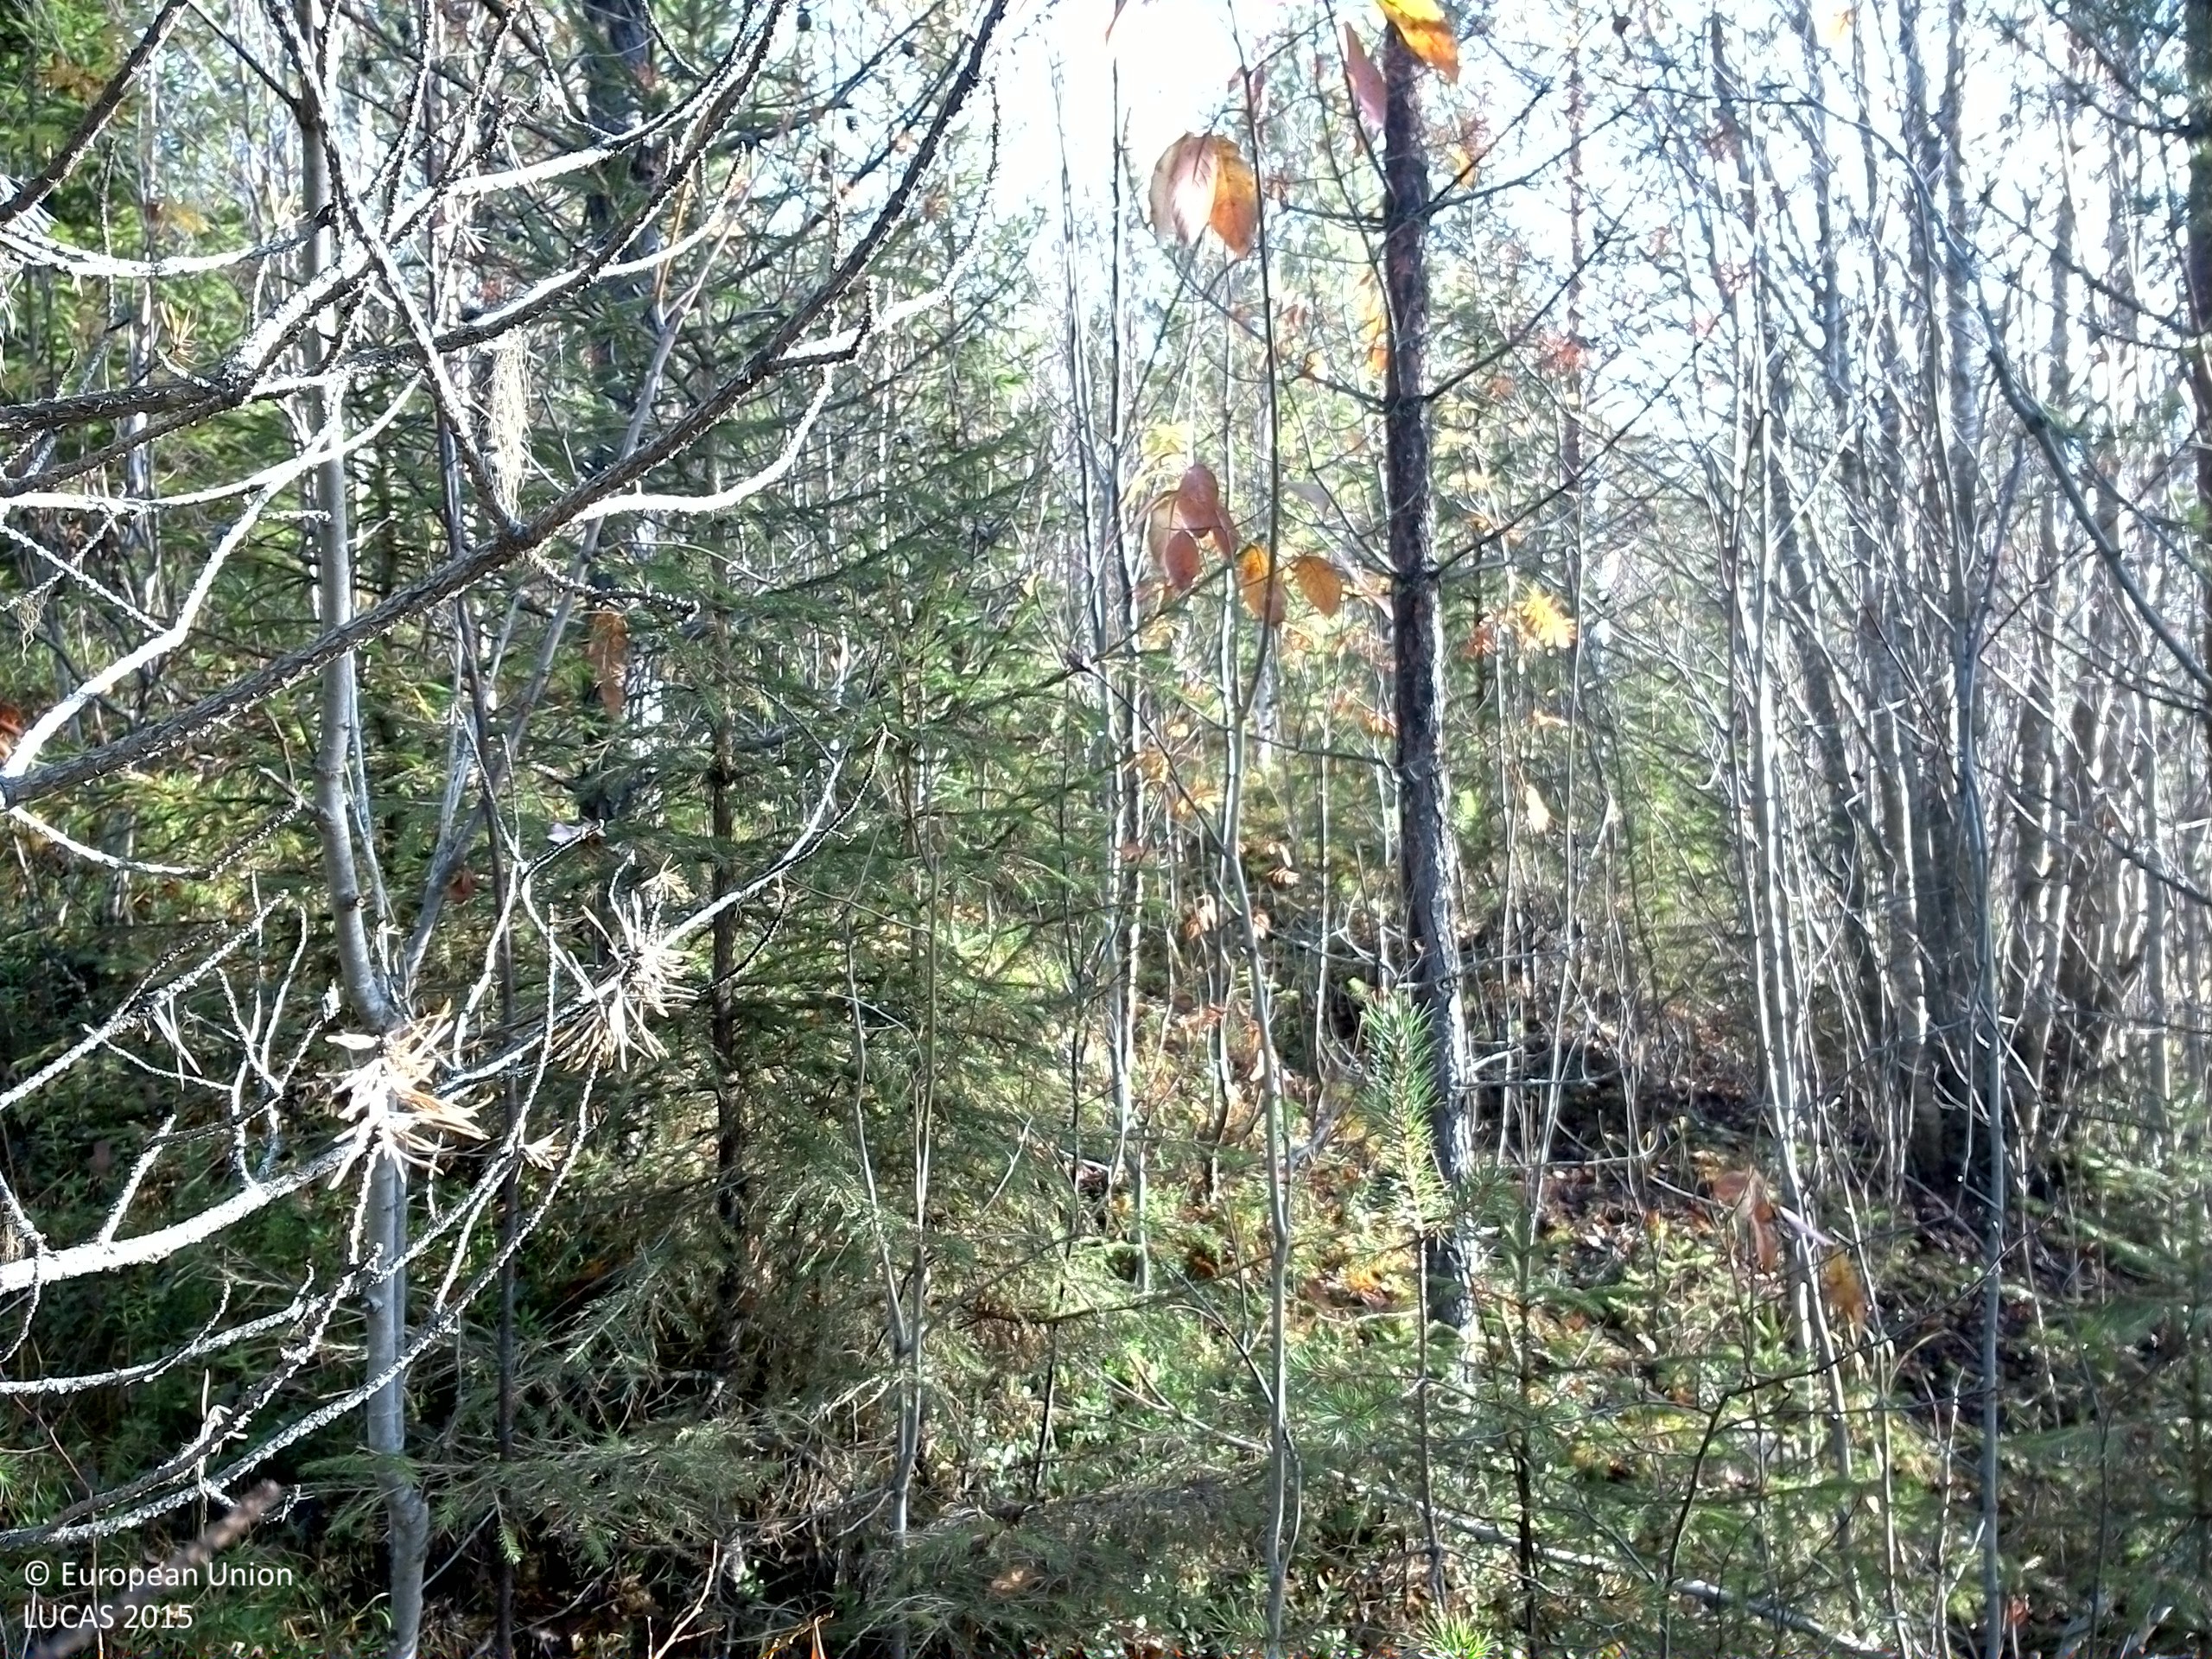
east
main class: Woodland
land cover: Pine dominated mixed woodland
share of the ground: 50 - 75 %
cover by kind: coniferous forest trees 35 %, shrubs 30 %, broadleaved forest trees 20 %, lichens and mosses 10 %, herbaceous plants 5 %
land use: Forestry
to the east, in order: Pine dominated mixed woodland; Pine dominated coniferous woodland; Pine dominated mixed woodland; Pine dominated coniferous woodland
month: October
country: SE
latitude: 64.1011
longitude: 16.0653
